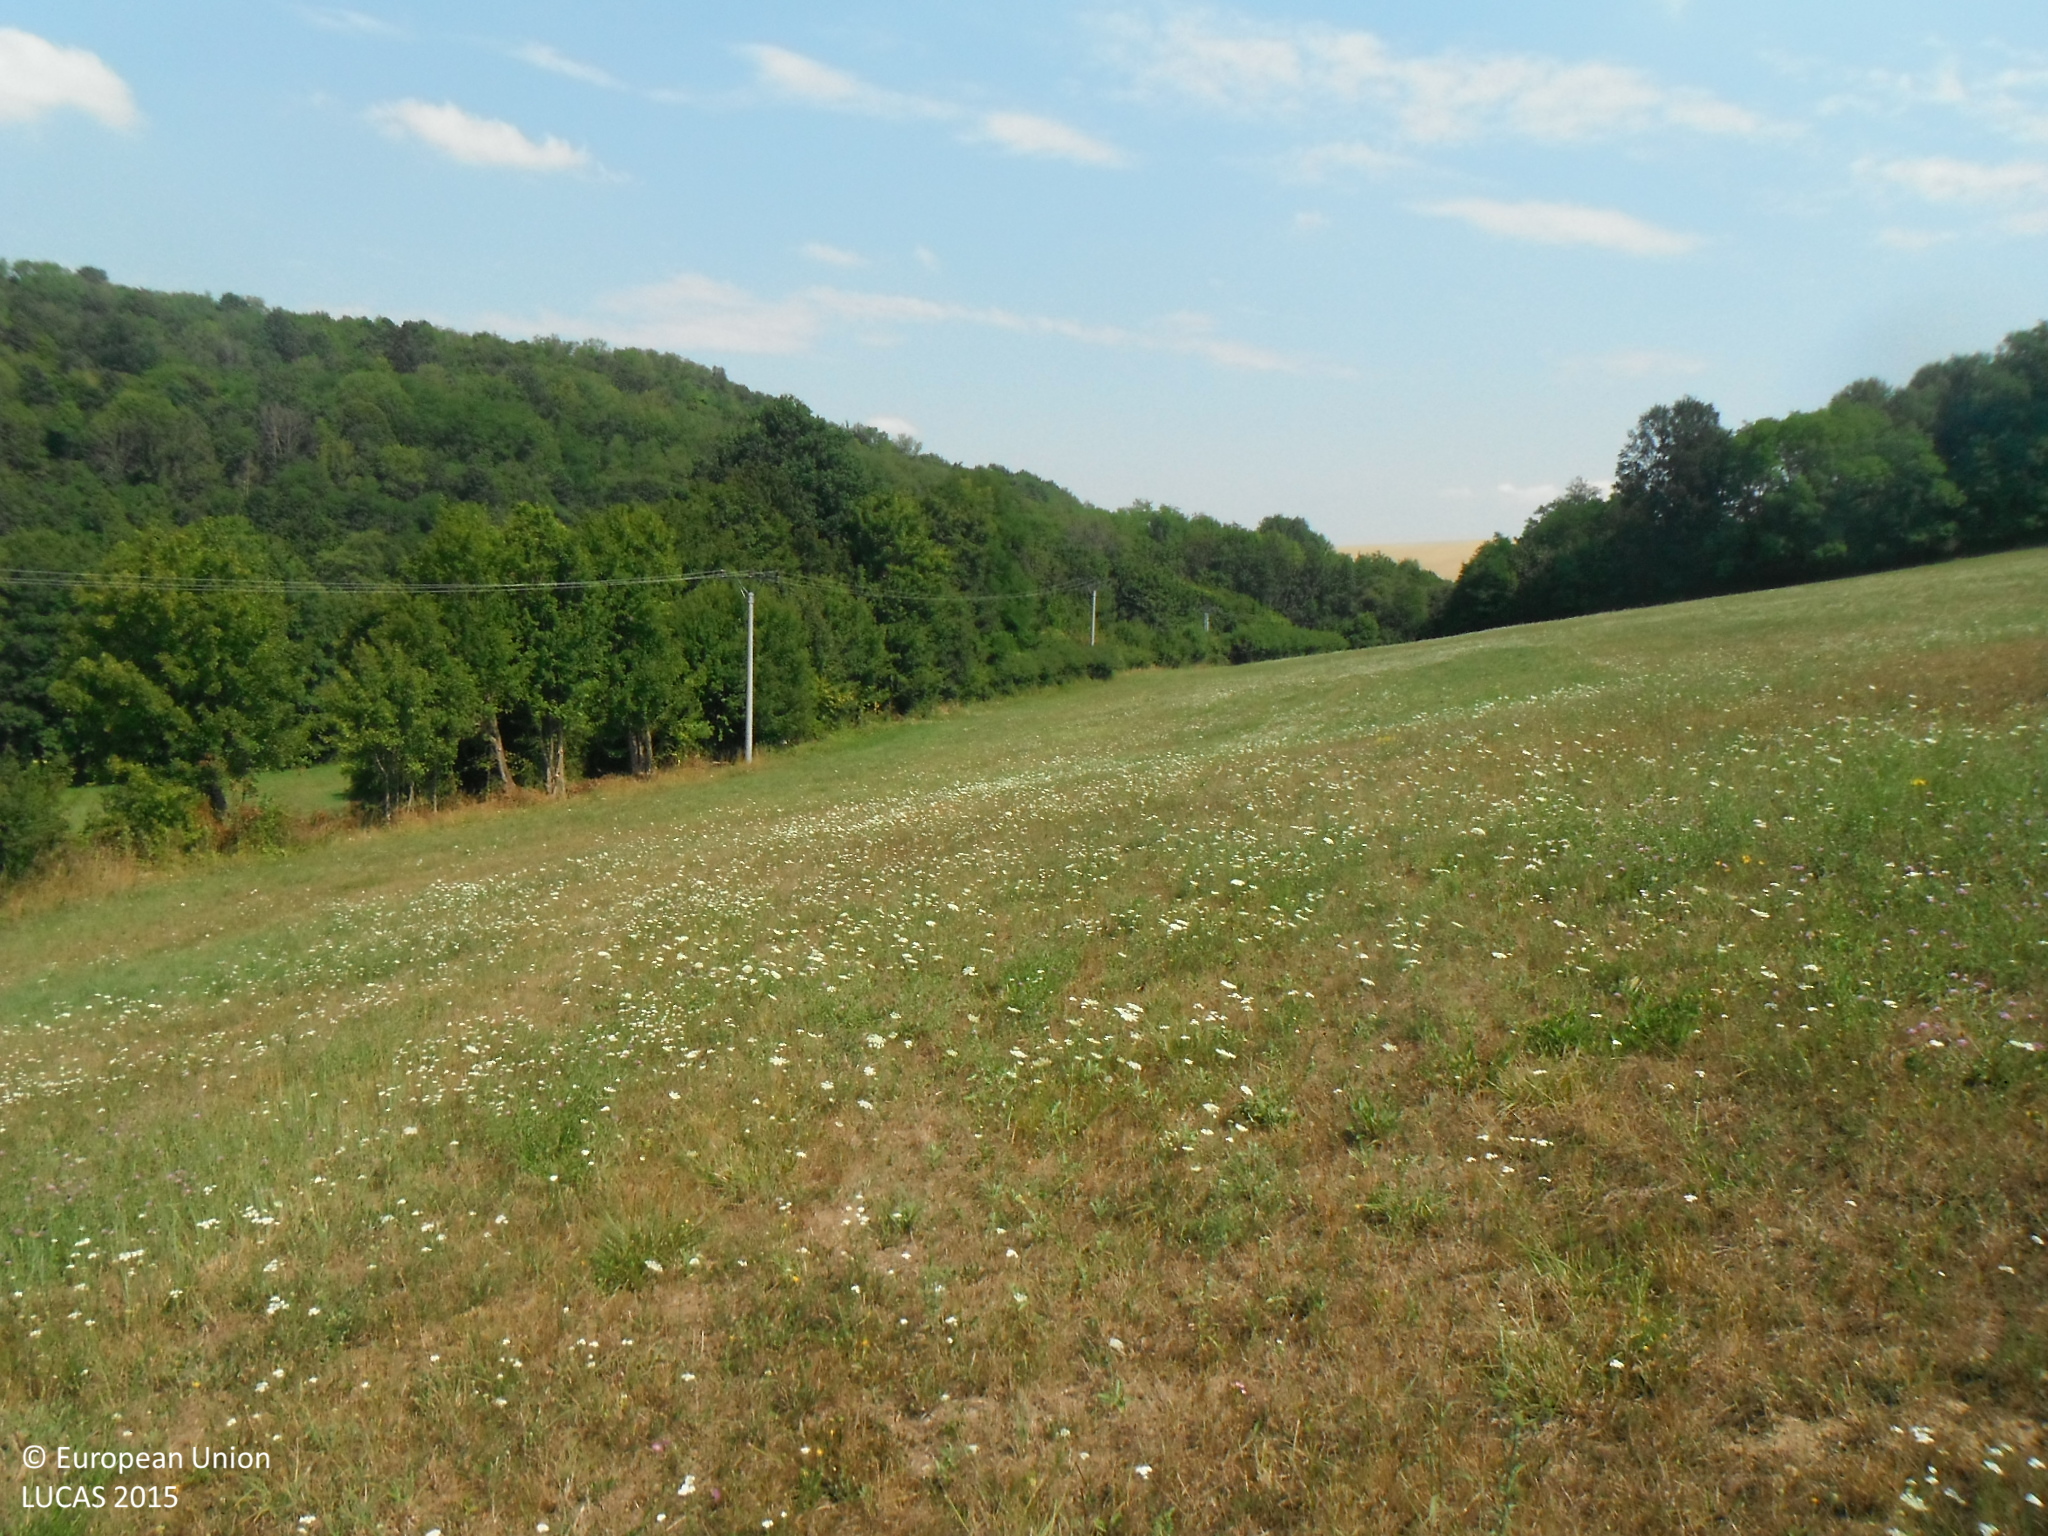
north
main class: Grassland
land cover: Grassland without tree/shrub cover
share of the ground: > 75 %
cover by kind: herbaceous plants 100 %
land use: Agriculture (excluding fallow land and kitchen gardens)
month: July
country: SK
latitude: 48.6748
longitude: 17.4665
